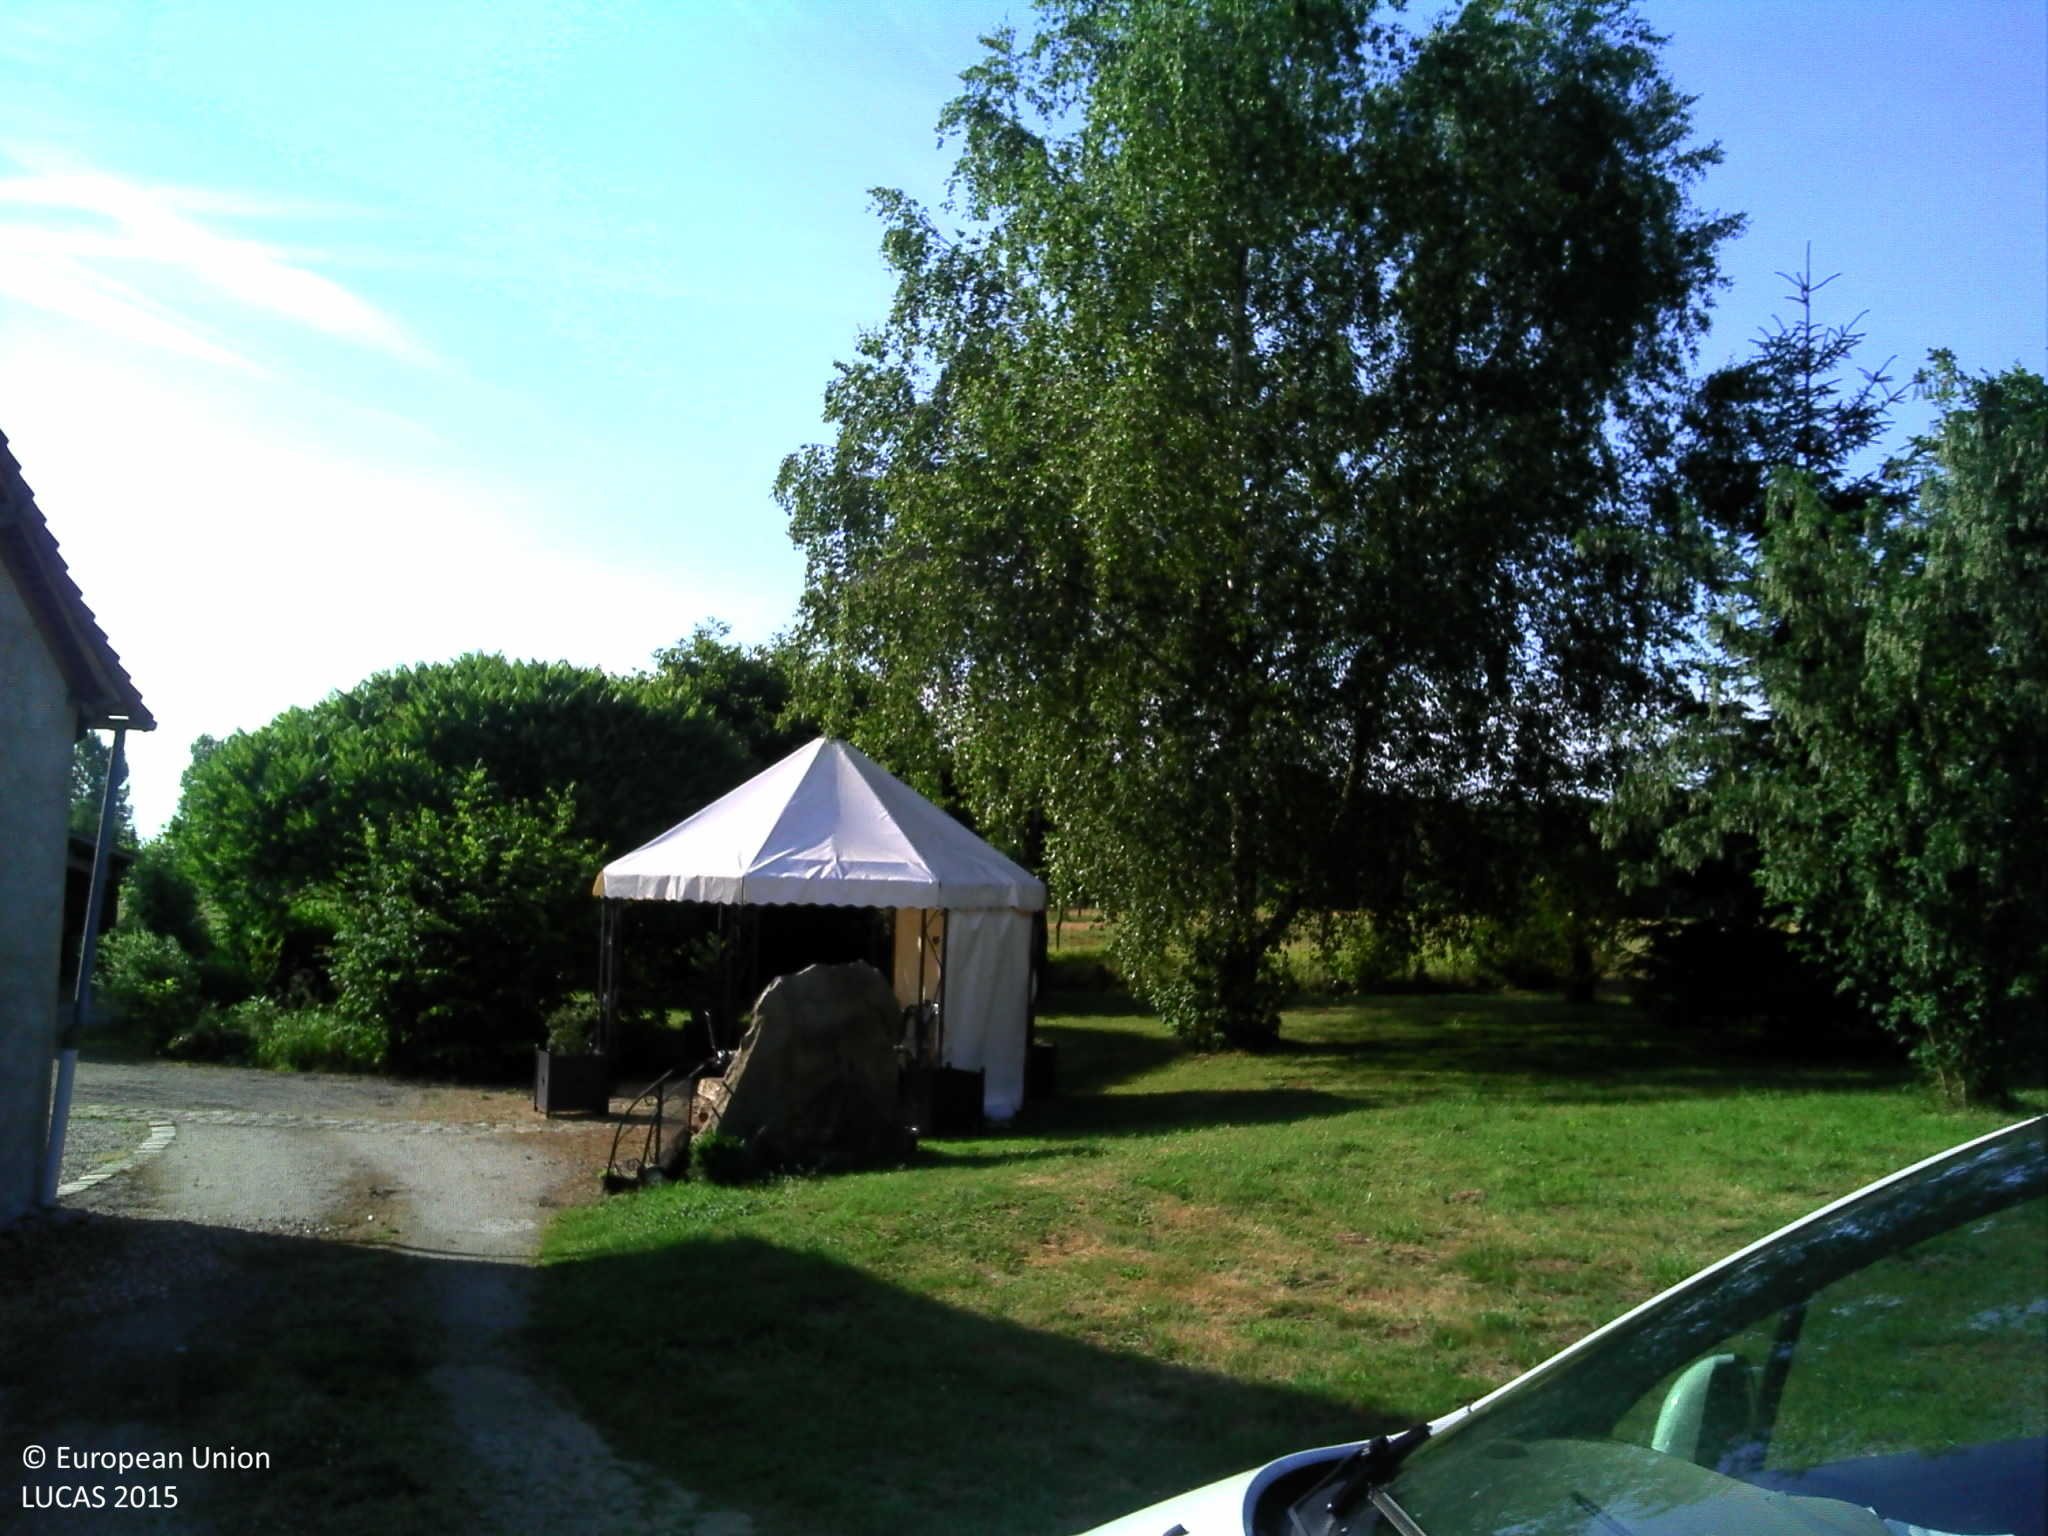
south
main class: Grassland
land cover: Grassland without tree/shrub cover
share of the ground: > 75 %
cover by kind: herbaceous plants 100 %
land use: Agriculture (excluding fallow land and kitchen gardens)
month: June
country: FR
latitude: 48.0488
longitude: 0.3024
